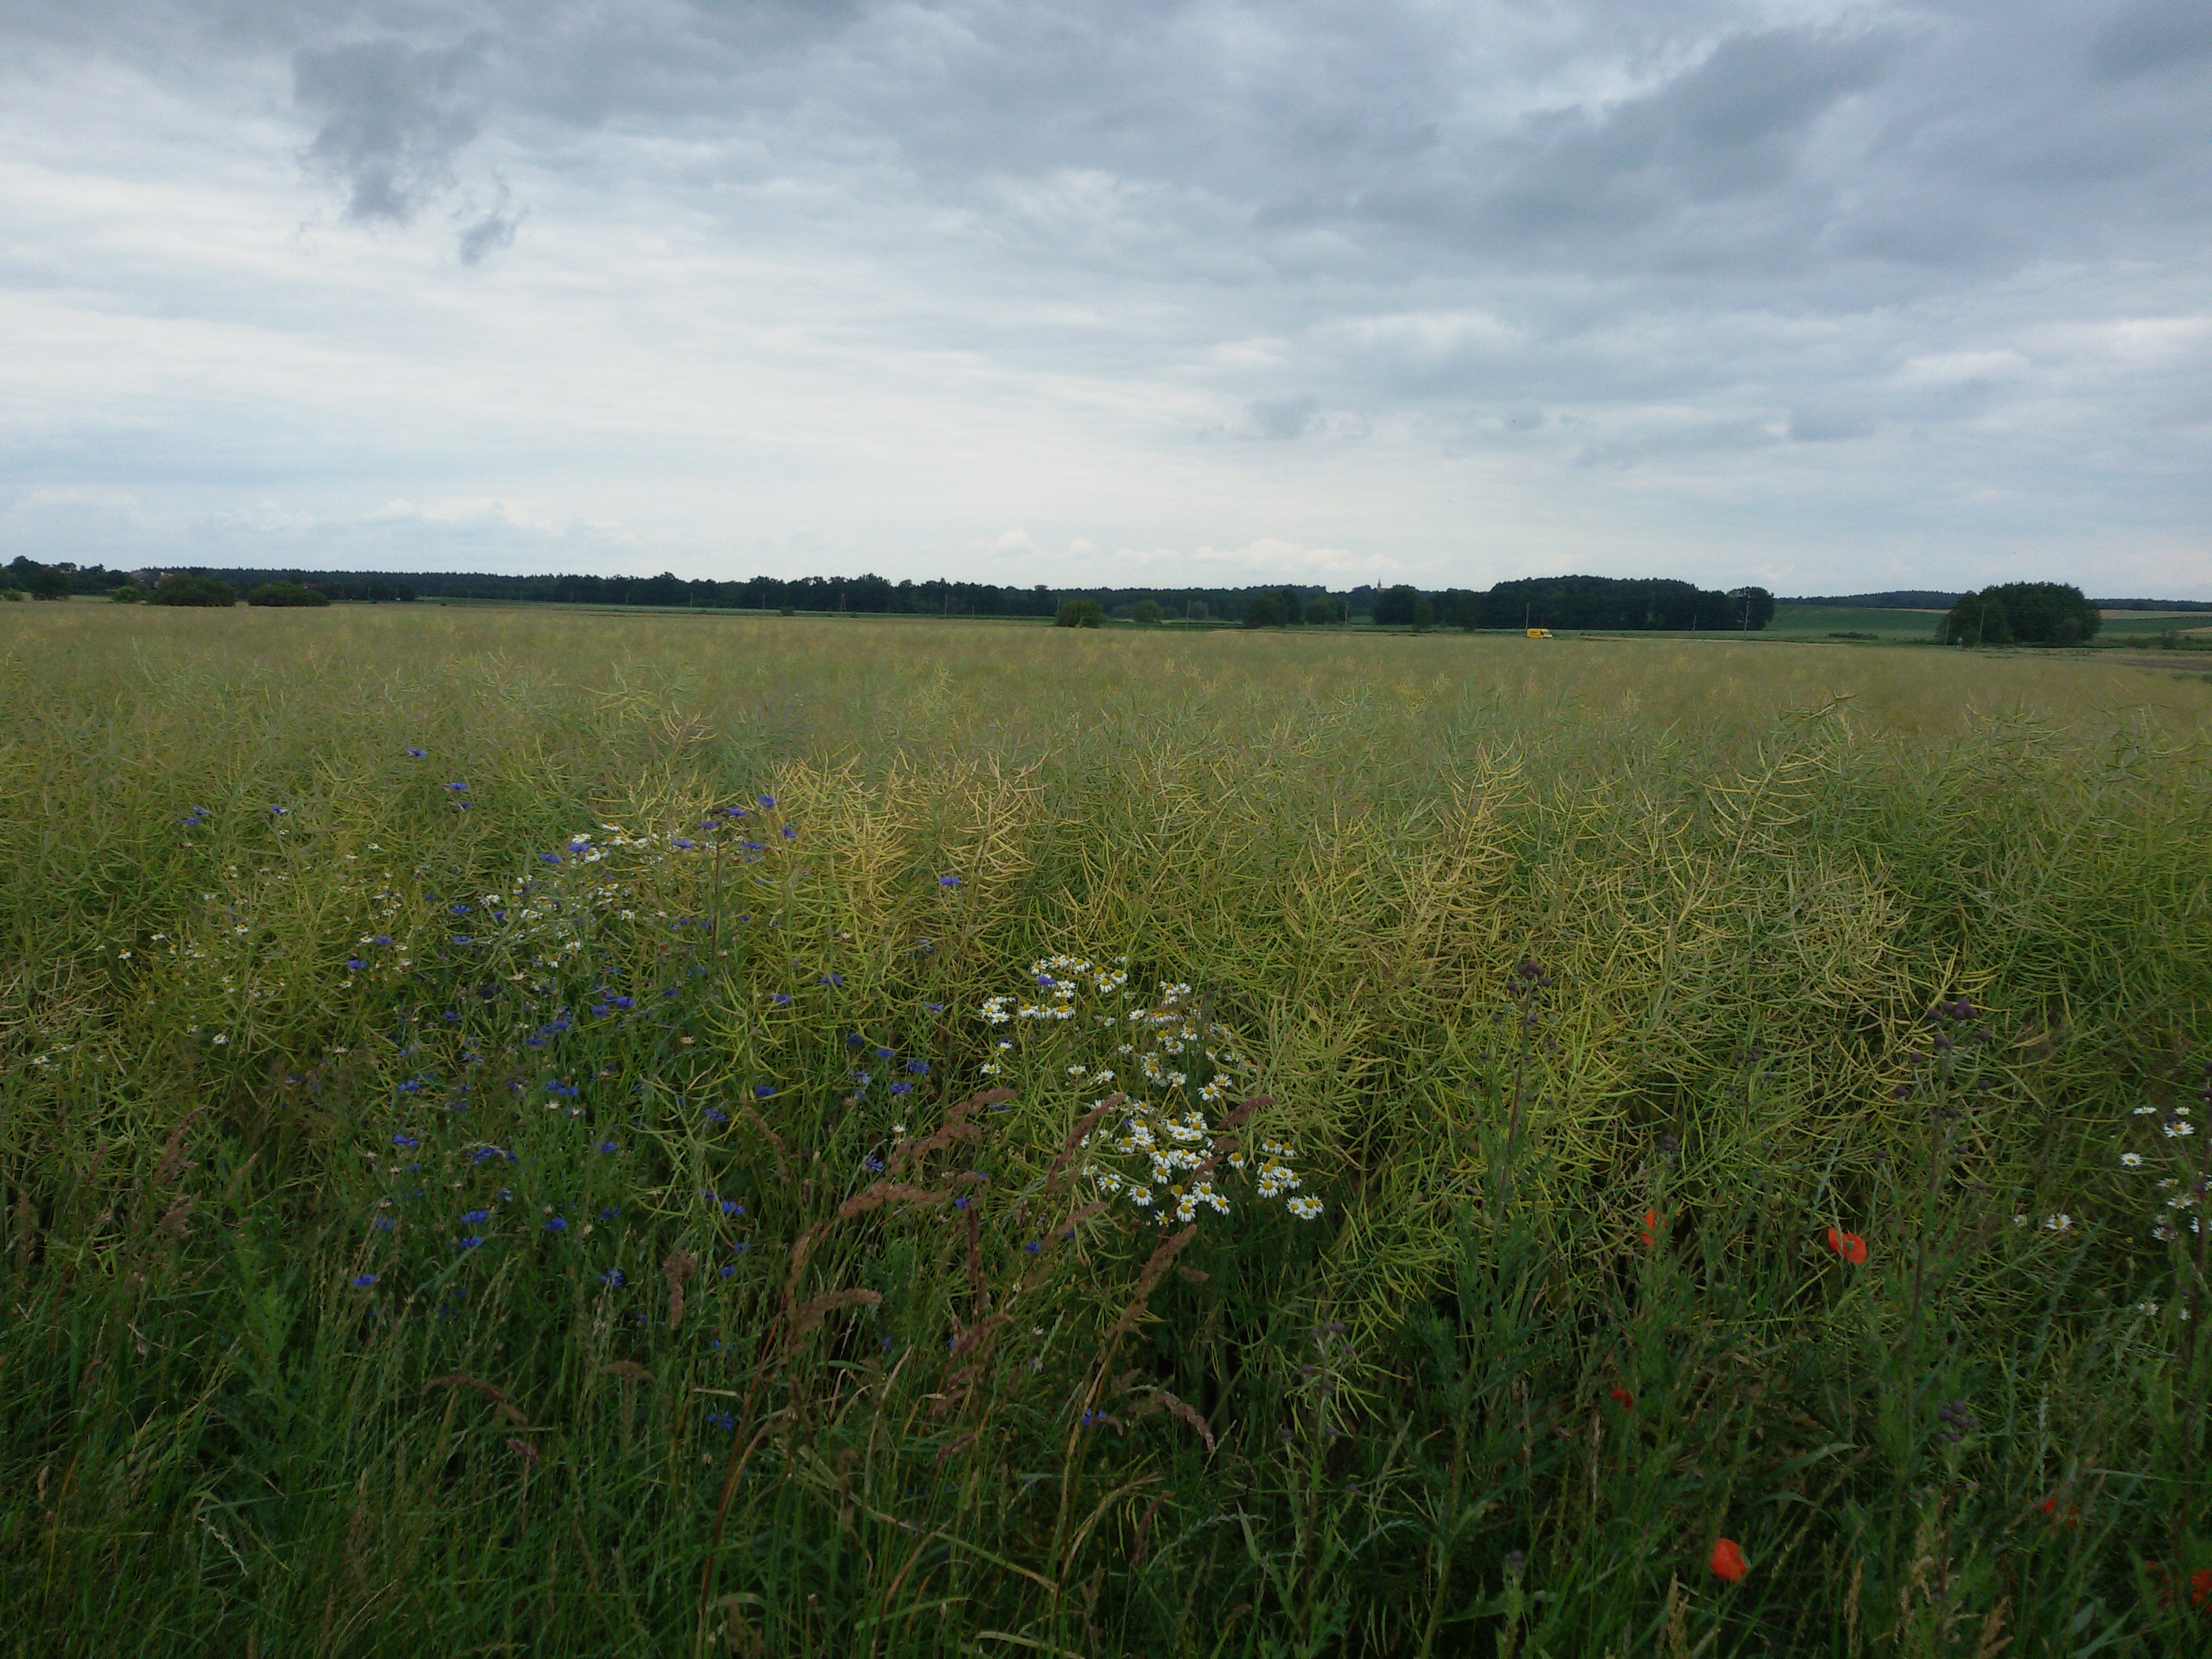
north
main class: Cropland
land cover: Rape and turnip rape
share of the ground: > 75 %
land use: Agriculture (excluding fallow land and kitchen gardens)
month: June
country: PL
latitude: 50.6956
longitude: 17.2171
